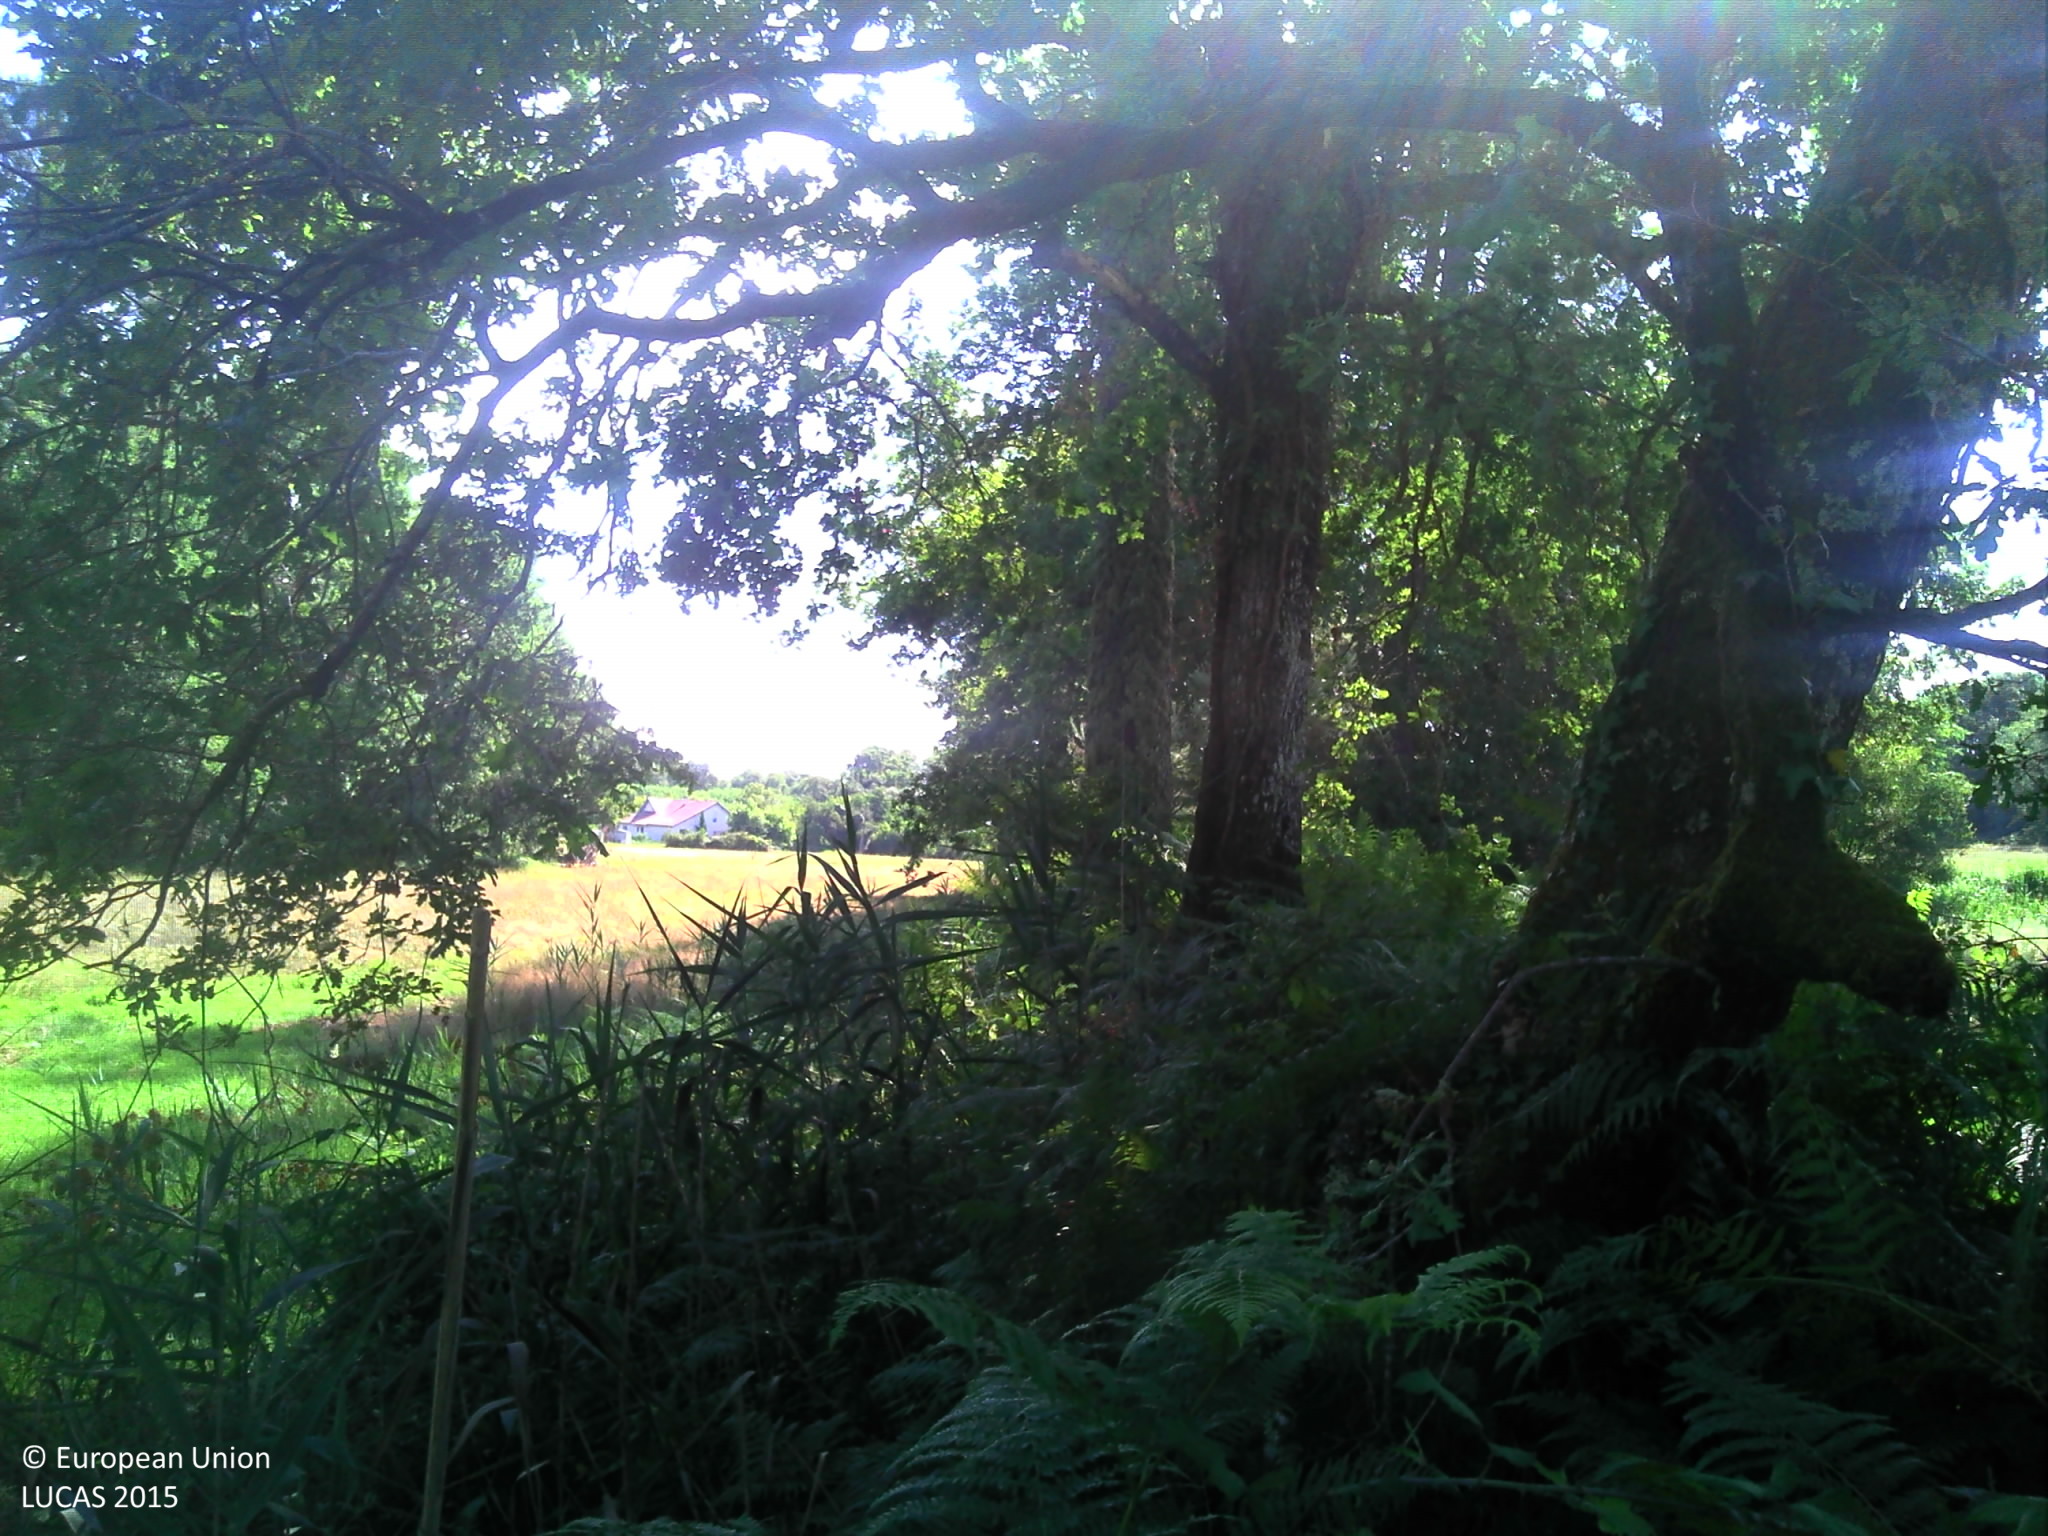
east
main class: Woodland
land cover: Broadleaved woodland
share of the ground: > 75 %
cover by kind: broadleaved forest trees 50 %, herbaceous plants 40 %, shrubs 10 %
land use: Semi-natural and natural areas not in use
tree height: > 5 m
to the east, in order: Broadleaved woodland; Rivers and streams; Broadleaved woodland; Shrubland without tree cover; Grassland without tree/shrub cover; Broadleaved woodland; Grassland without tree/shrub cover
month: July
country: FR
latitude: 43.8988
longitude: -0.5825
